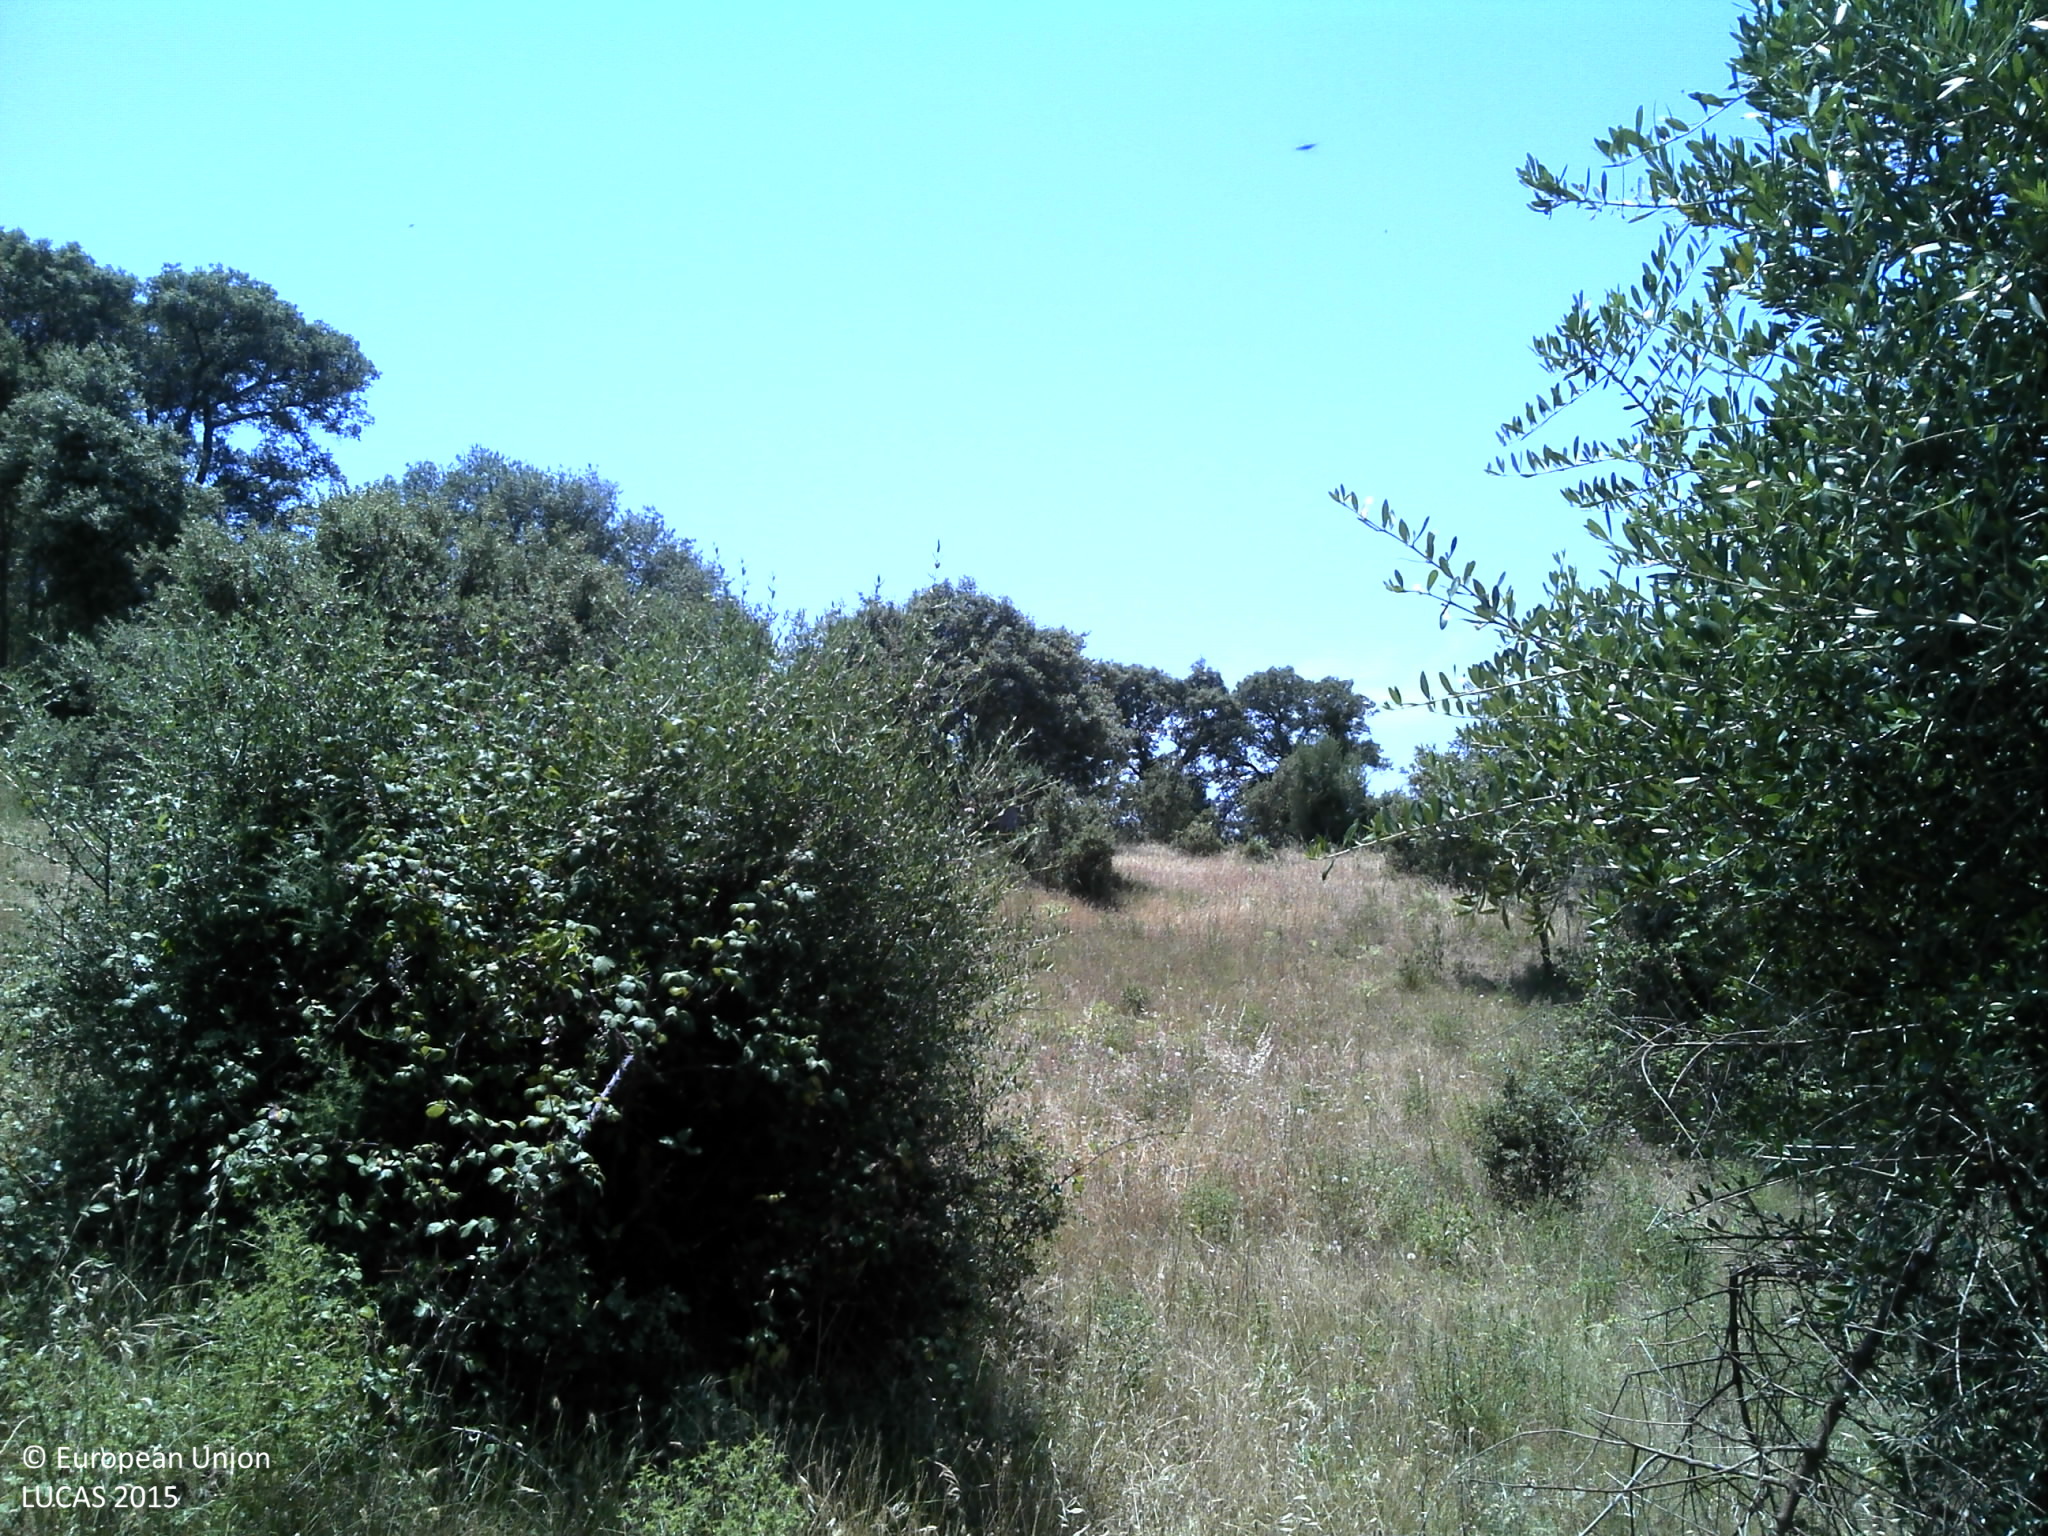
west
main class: Woodland
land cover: Broadleaved woodland
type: broadleaved evergreen forest
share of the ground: 10 - 25 %
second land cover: Grassland without tree/shrub cover
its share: 50 - 75 %
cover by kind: herbaceous plants 75 %, broadleaved forest trees 15 %, unconsolidated bare surface 10 %
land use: Forestry
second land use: Agriculture (excluding fallow land and kitchen gardens)
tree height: < 5 m
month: June
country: PT
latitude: 38.6432
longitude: -8.1893
